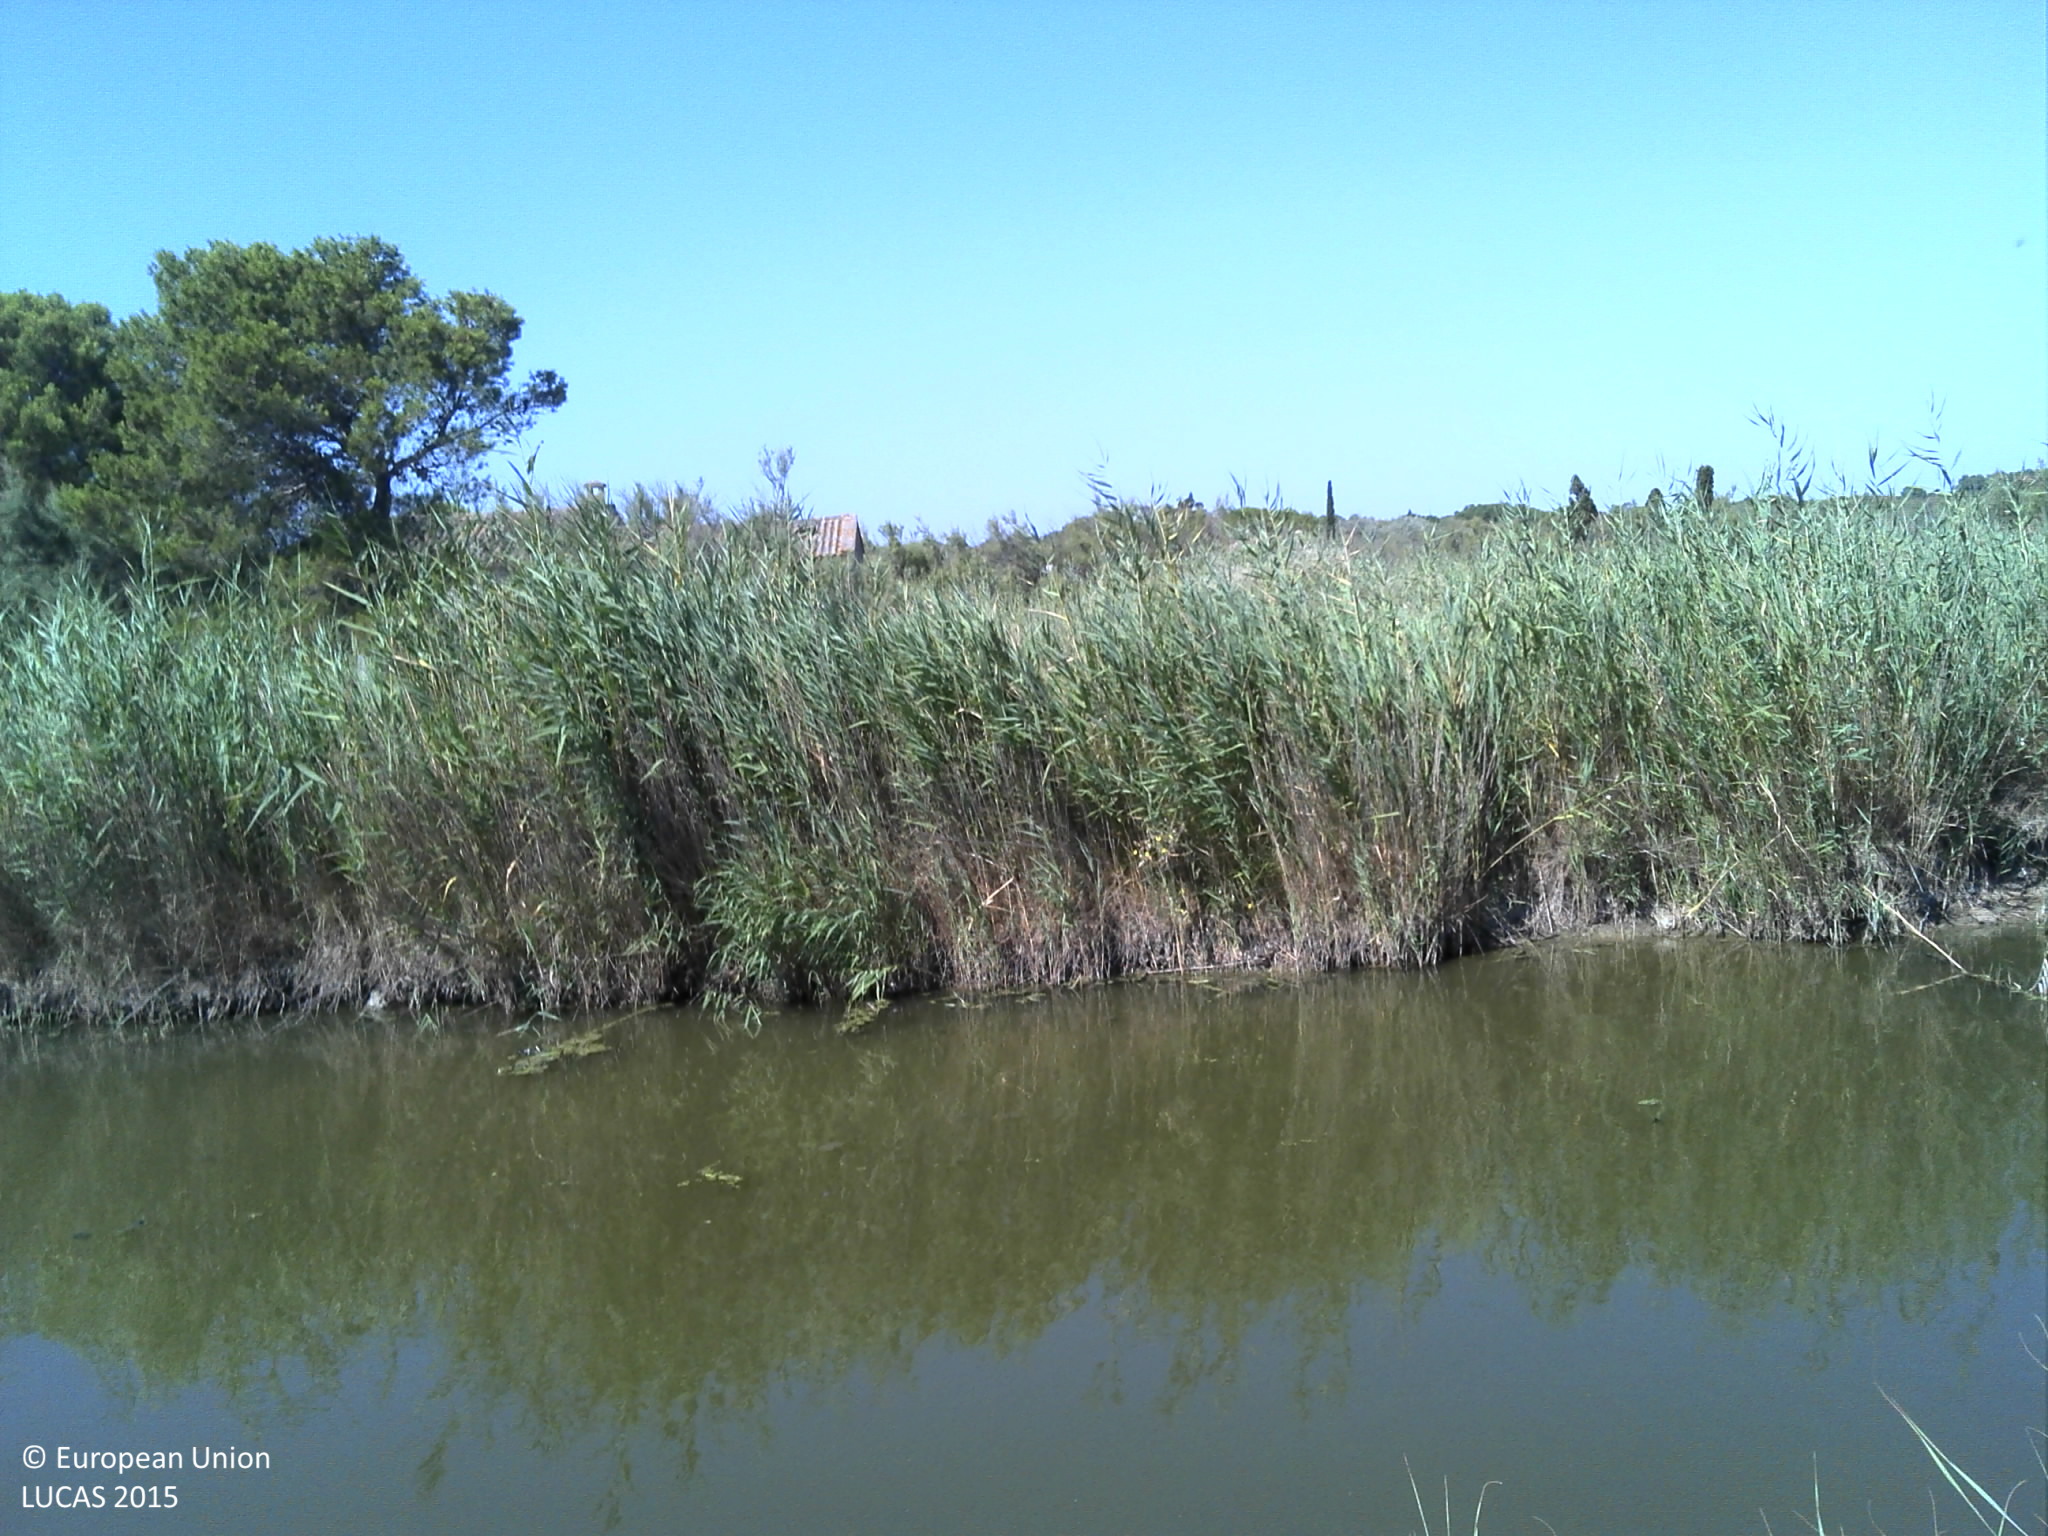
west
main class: Grassland
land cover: Spontaneously vegetated surfaces
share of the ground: > 75 %
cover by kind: herbaceous plants 100 %
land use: Semi-natural and natural areas not in use
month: July
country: FR
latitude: 43.5997
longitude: 4.0260
